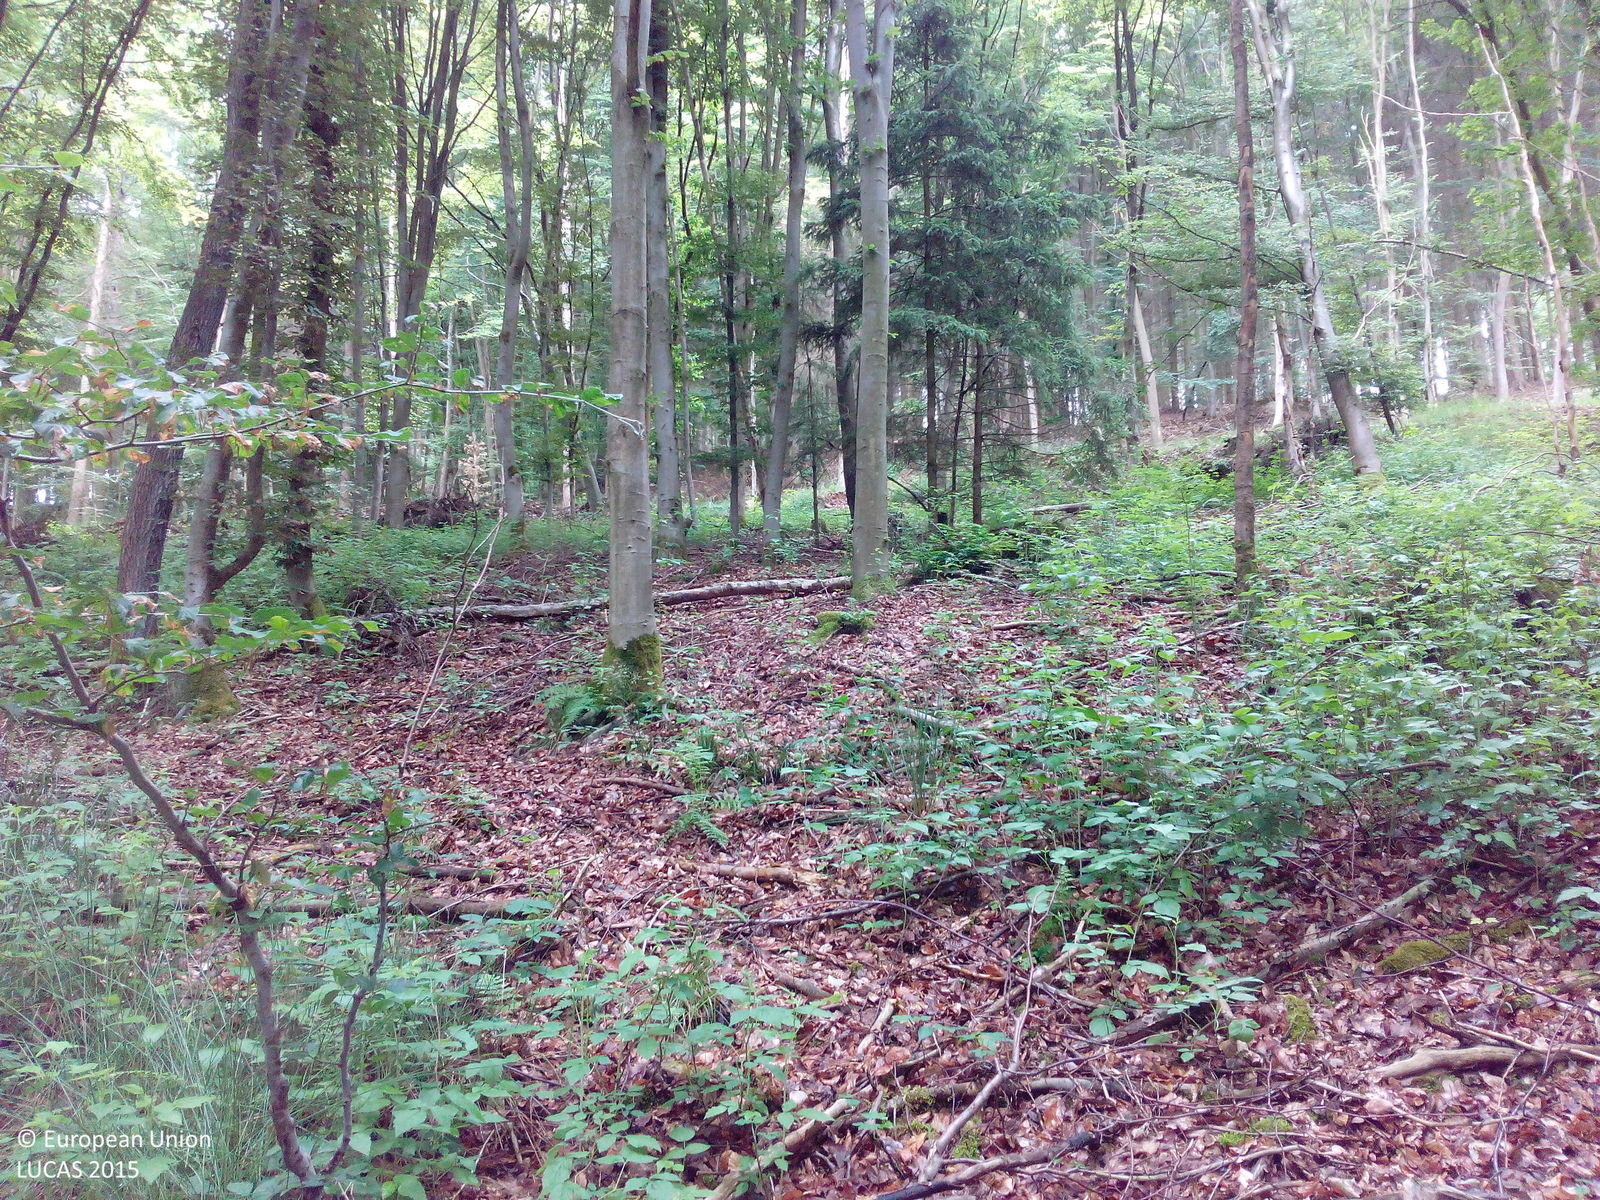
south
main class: Woodland
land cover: Broadleaved woodland
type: beech forest
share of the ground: > 75 %
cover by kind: broadleaved forest trees 85 %, herbaceous plants 10 %, coniferous forest trees 5 %
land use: Forestry
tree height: > 5 m
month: June
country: DE
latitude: 51.6220
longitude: 9.6390
